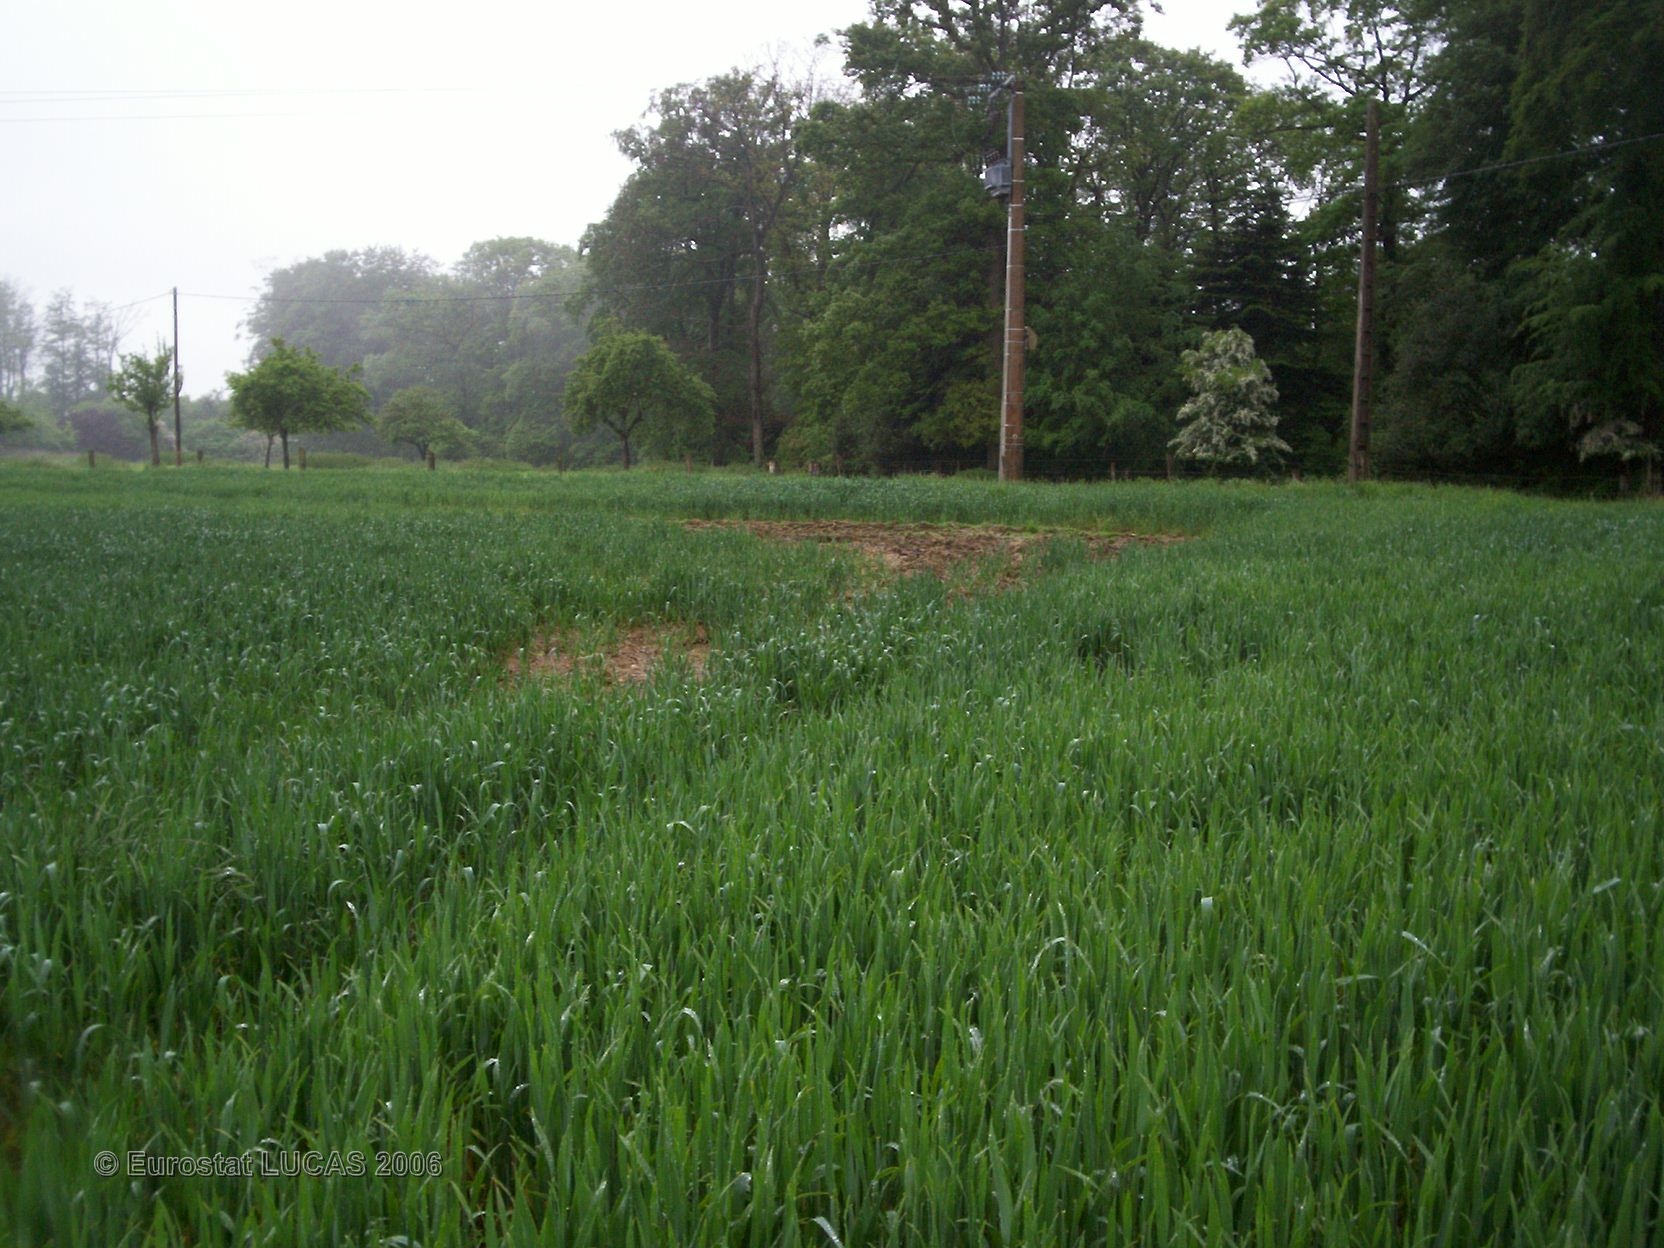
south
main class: Cropland
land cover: Common wheat
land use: Agriculture (excluding fallow land and kitchen gardens)
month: May
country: FR
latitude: 49.7298
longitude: 0.4696
